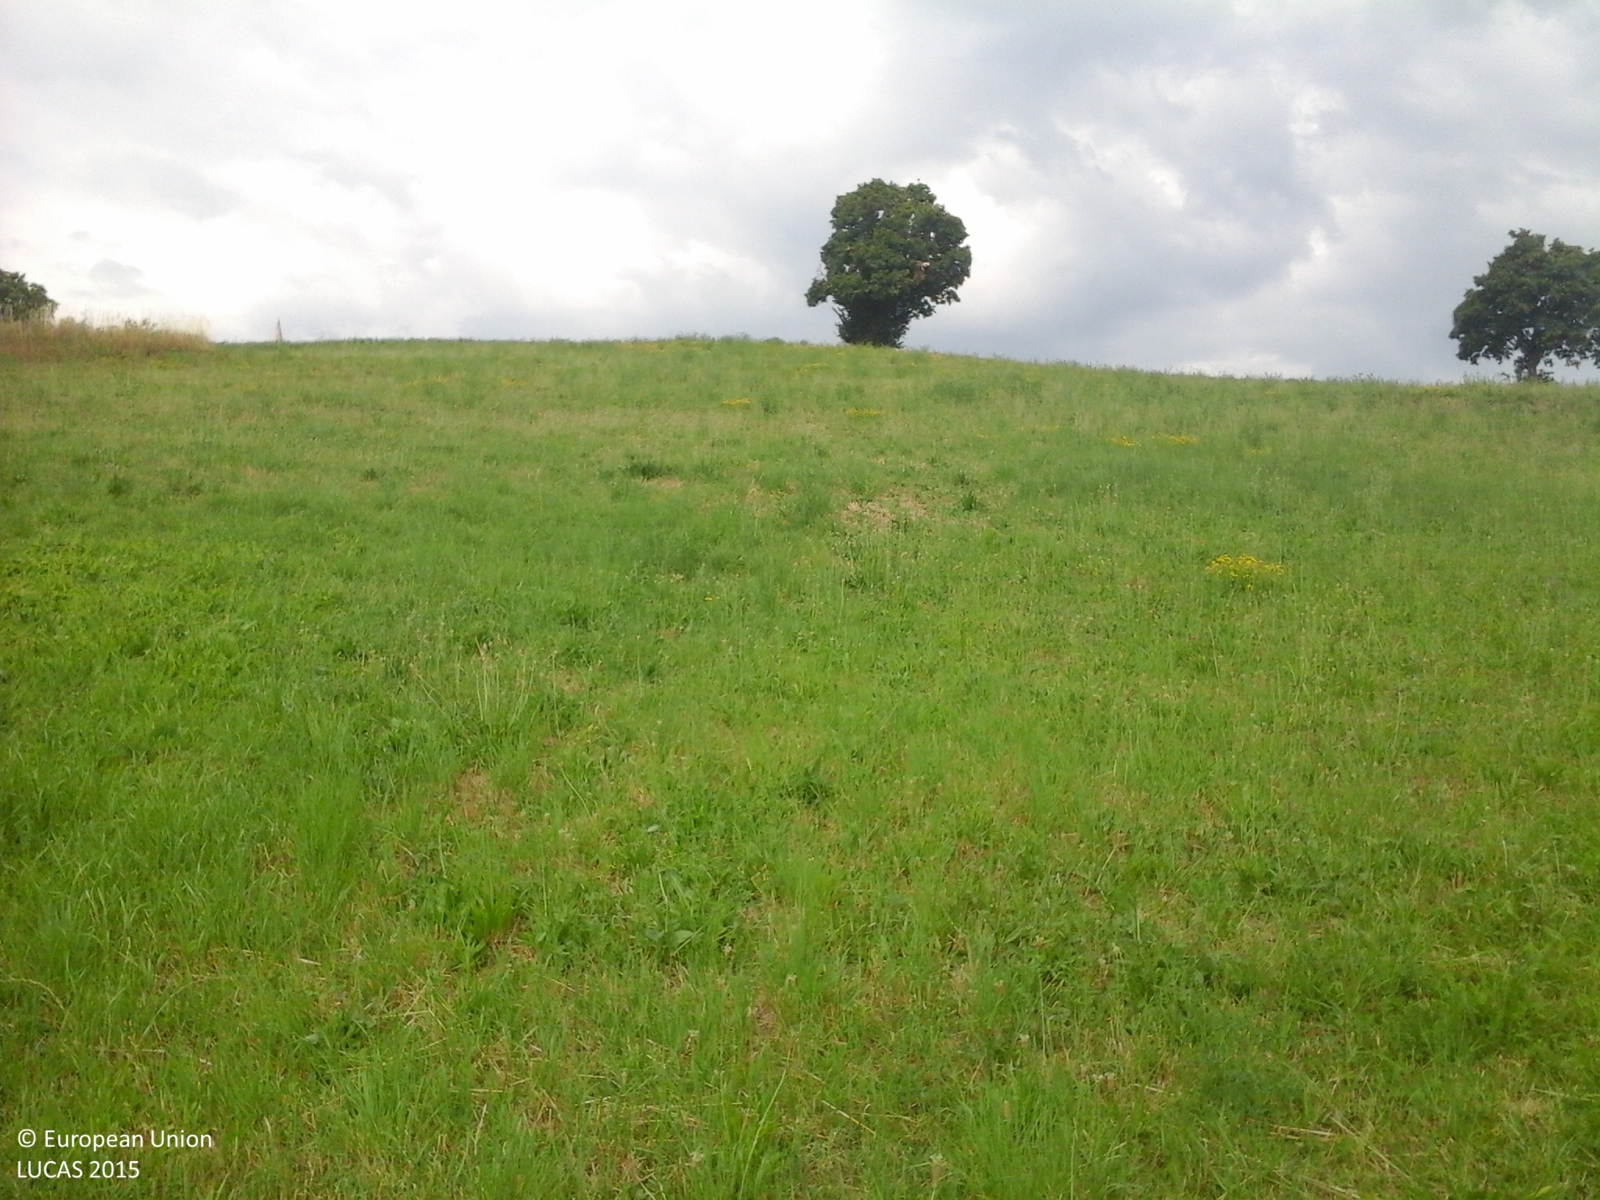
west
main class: Grassland
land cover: Grassland without tree/shrub cover
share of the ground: > 75 %
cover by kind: herbaceous plants 100 %
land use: Agriculture (excluding fallow land and kitchen gardens)
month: June
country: IT
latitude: 44.6207
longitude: 10.2641
